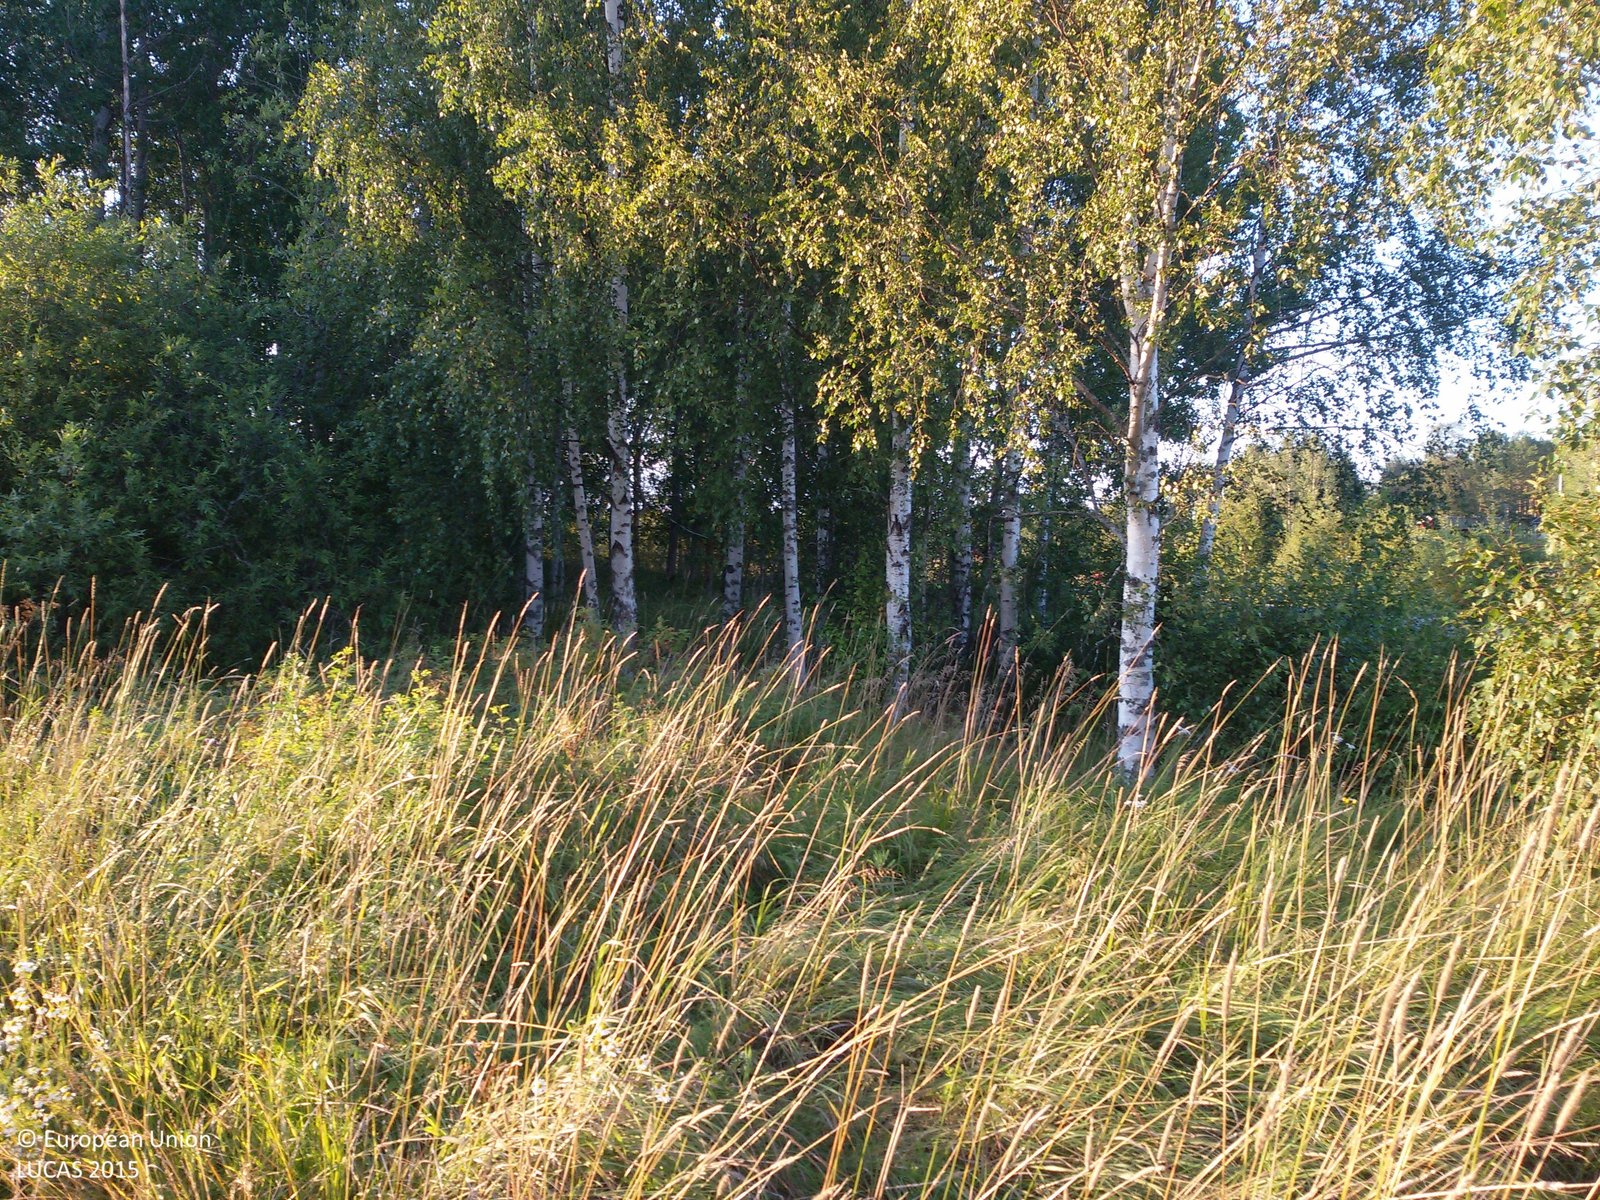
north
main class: Cropland
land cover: Barley
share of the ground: > 75 %
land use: Agriculture (excluding fallow land and kitchen gardens)
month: August
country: SE
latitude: 60.6216
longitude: 16.6217
